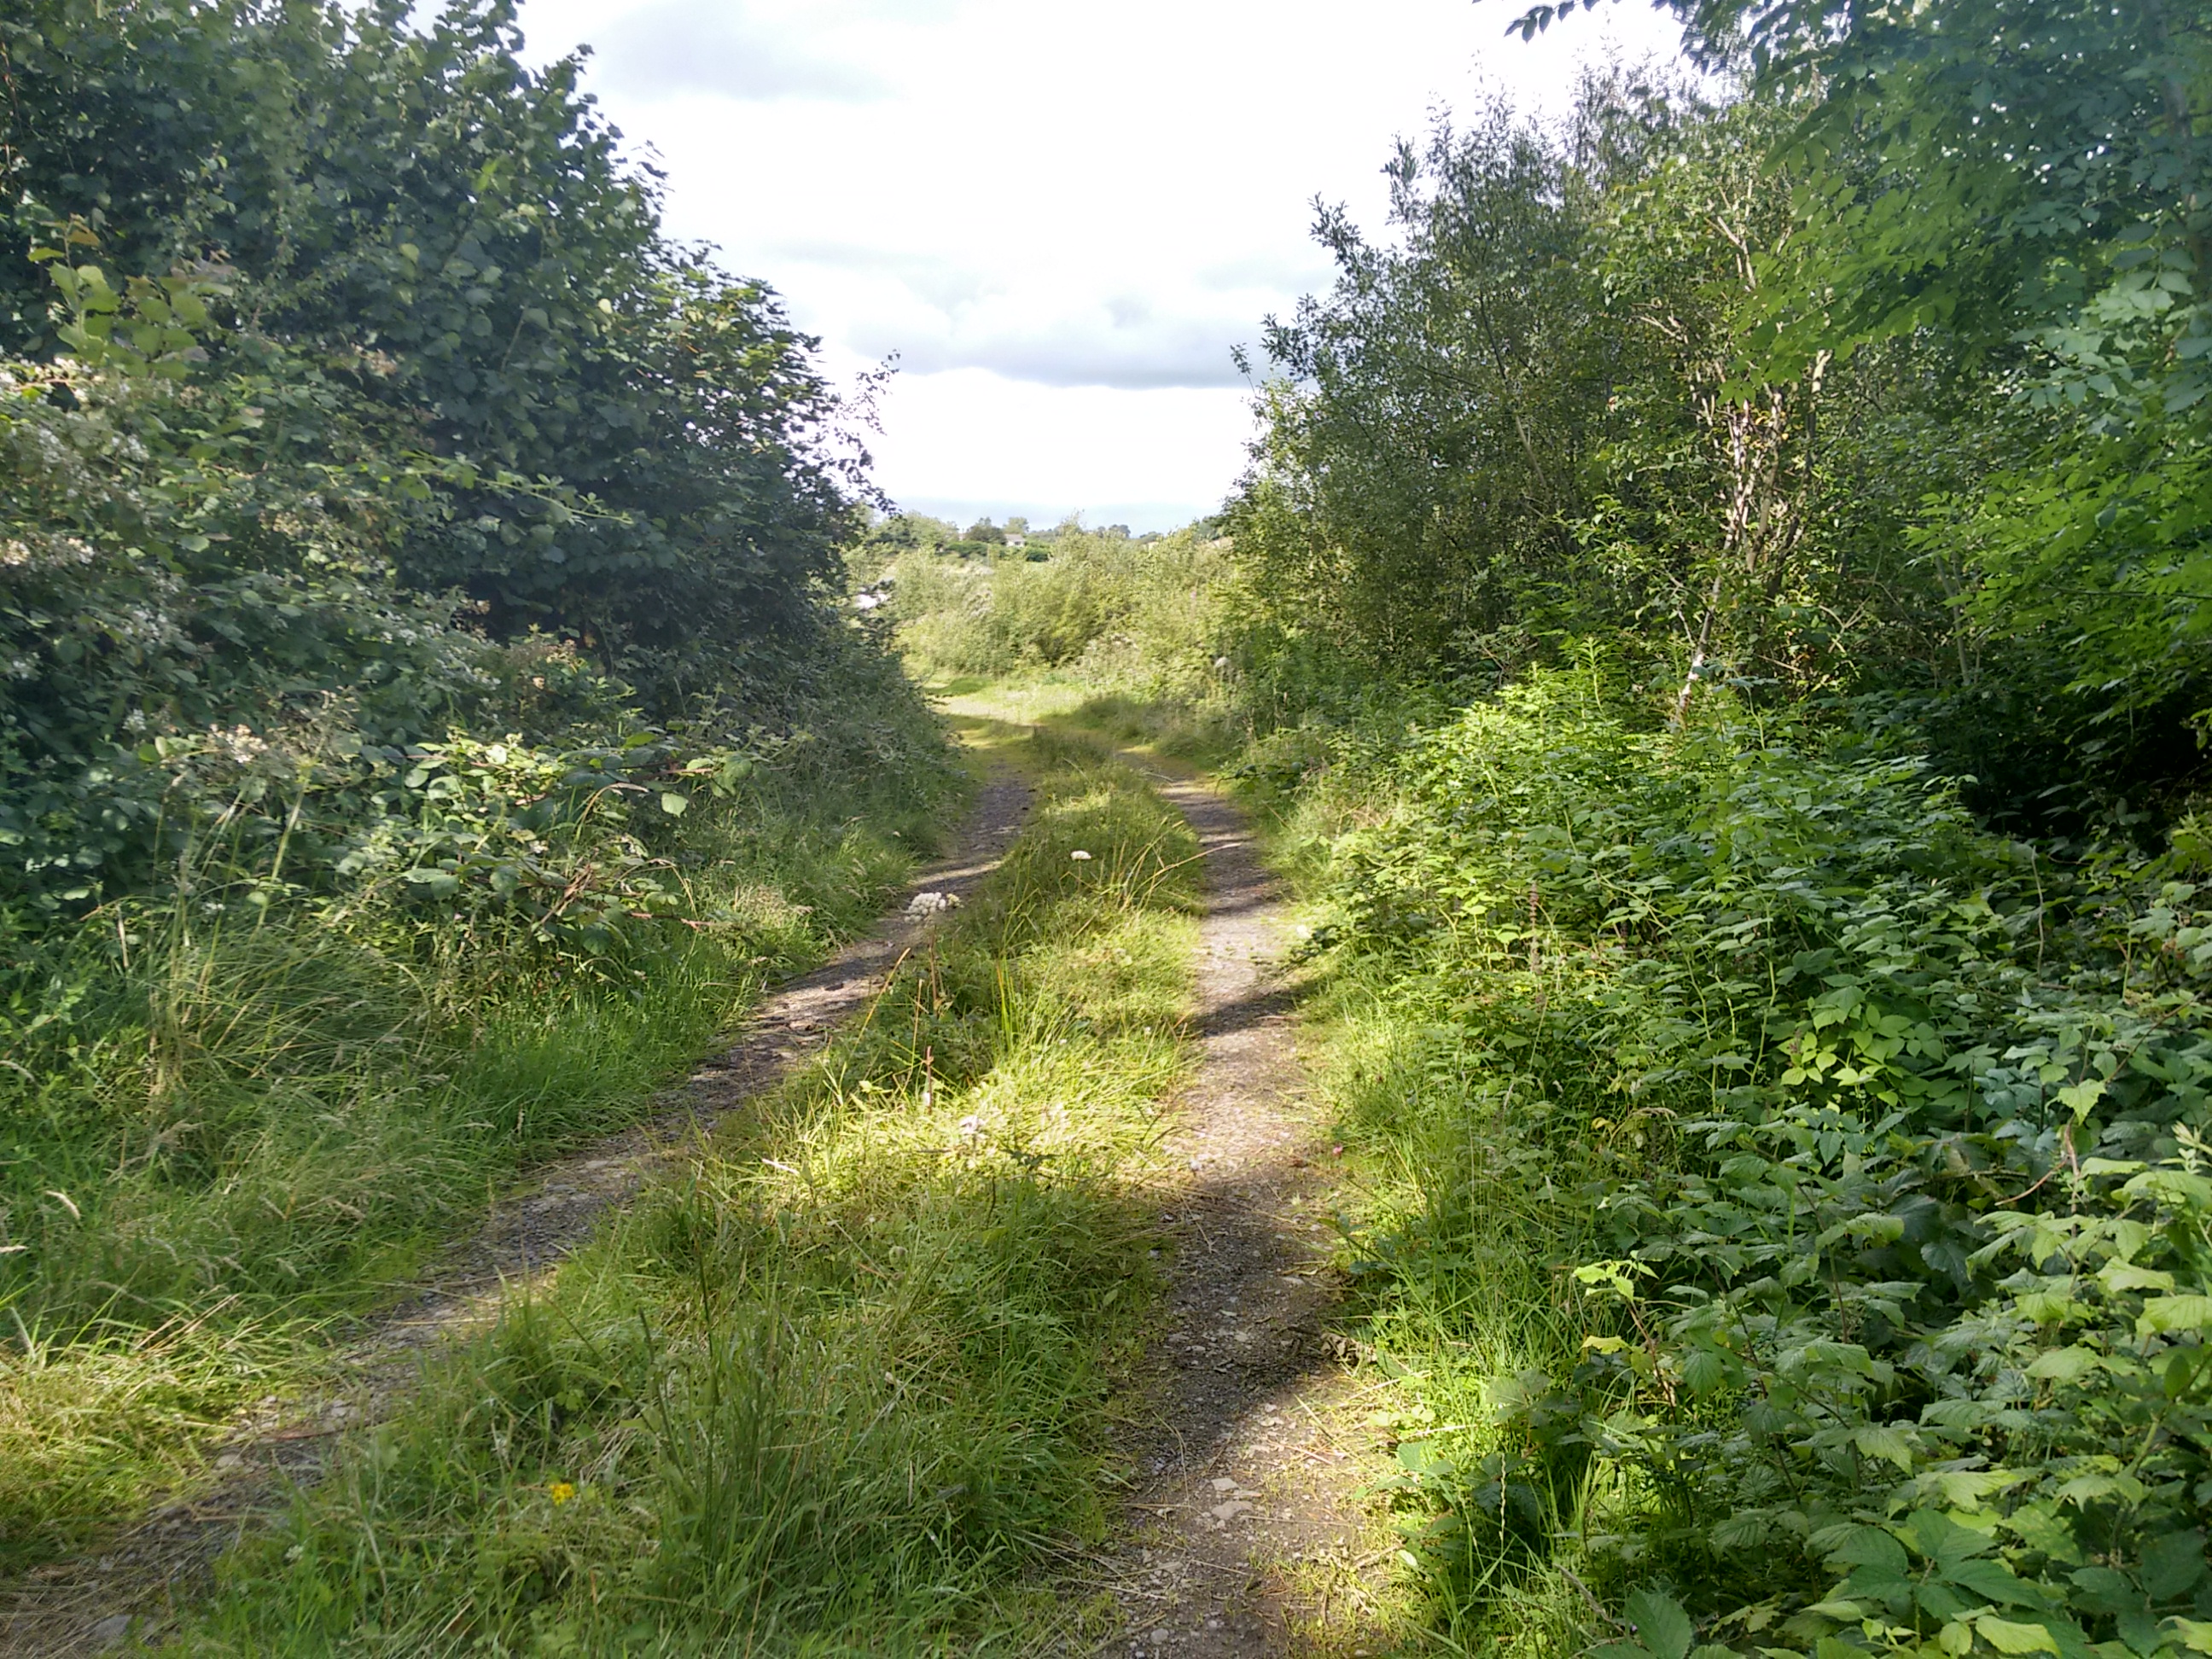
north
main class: Woodland
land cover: Other mixed woodland
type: exotic forest
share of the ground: > 75 %
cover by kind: coniferous forest trees 75 %, broadleaved forest trees 25 %
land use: Forestry
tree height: > 5 m
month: August
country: GB
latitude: 54.4764
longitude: -6.8164
